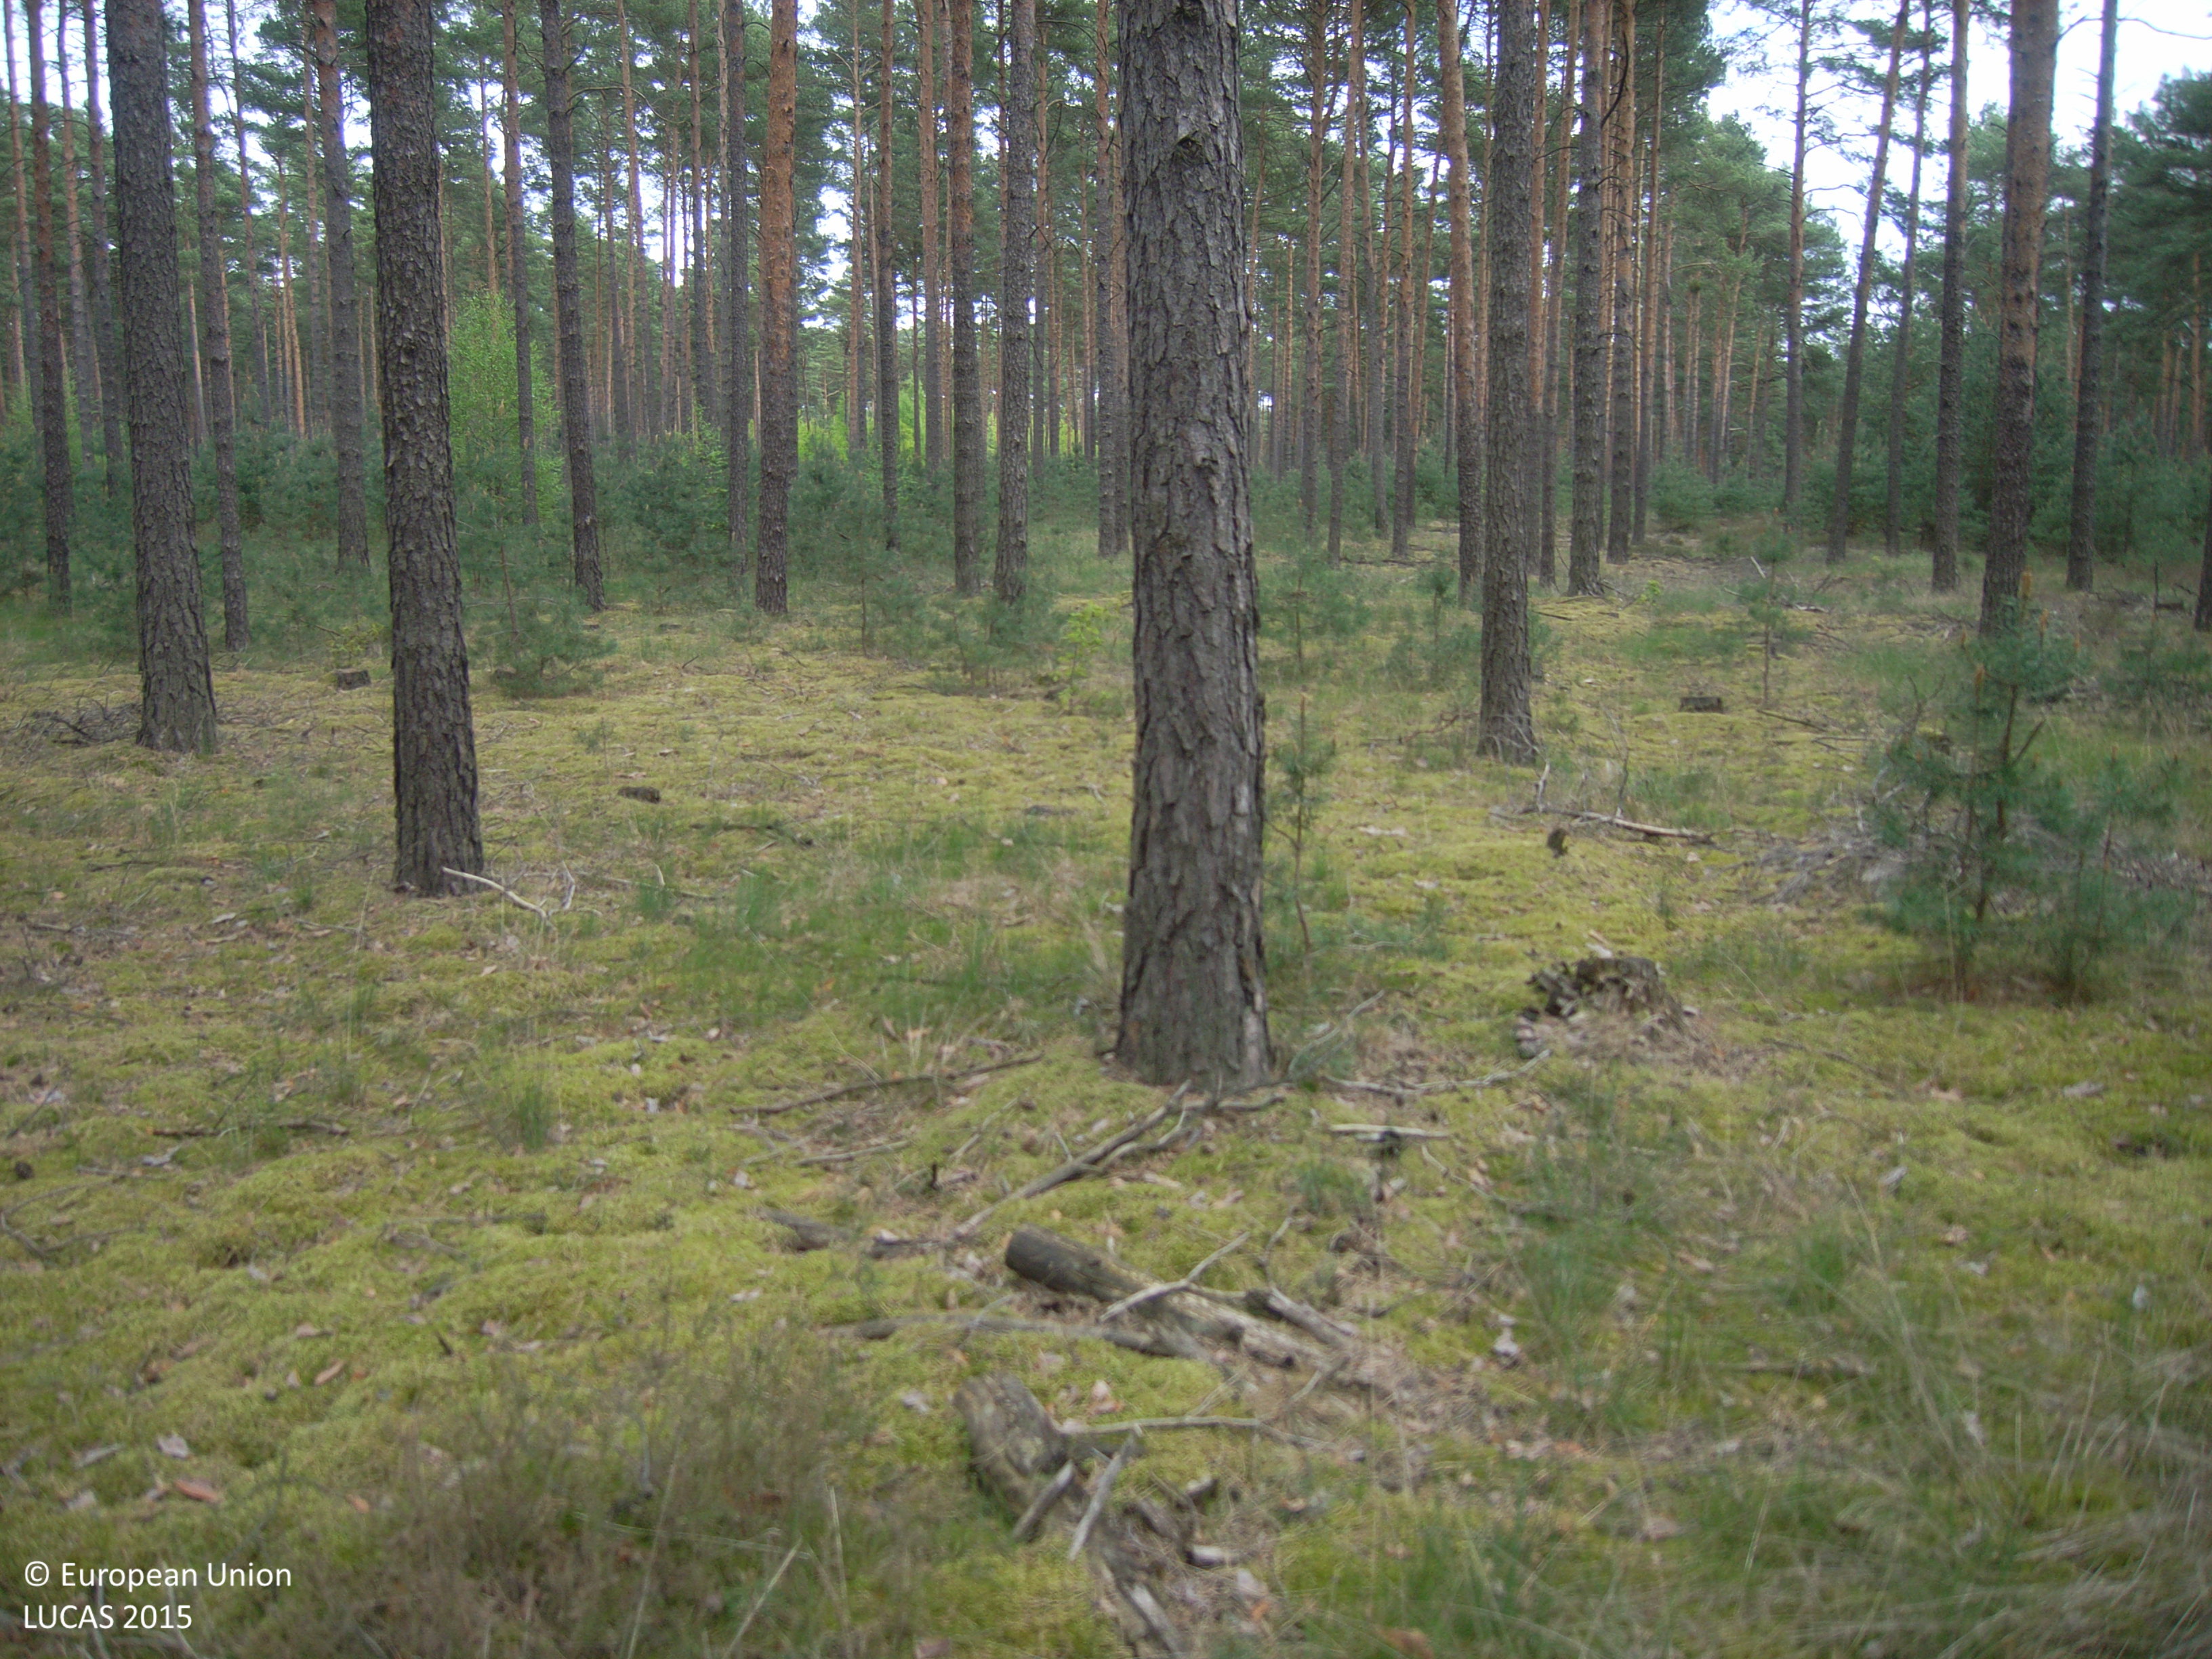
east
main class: Woodland
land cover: Pine dominated coniferous woodland
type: hemiboreal forest and nemoral coniferous forest and mixed broadleaved-coniferous forest
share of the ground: > 75 %
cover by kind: coniferous forest trees 100 %
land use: Forestry
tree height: > 5 m
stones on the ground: < 10 %
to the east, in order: Pine dominated coniferous woodland; Tracks; Broadleaved woodland
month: May
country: DE
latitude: 52.0898
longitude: 13.5762
